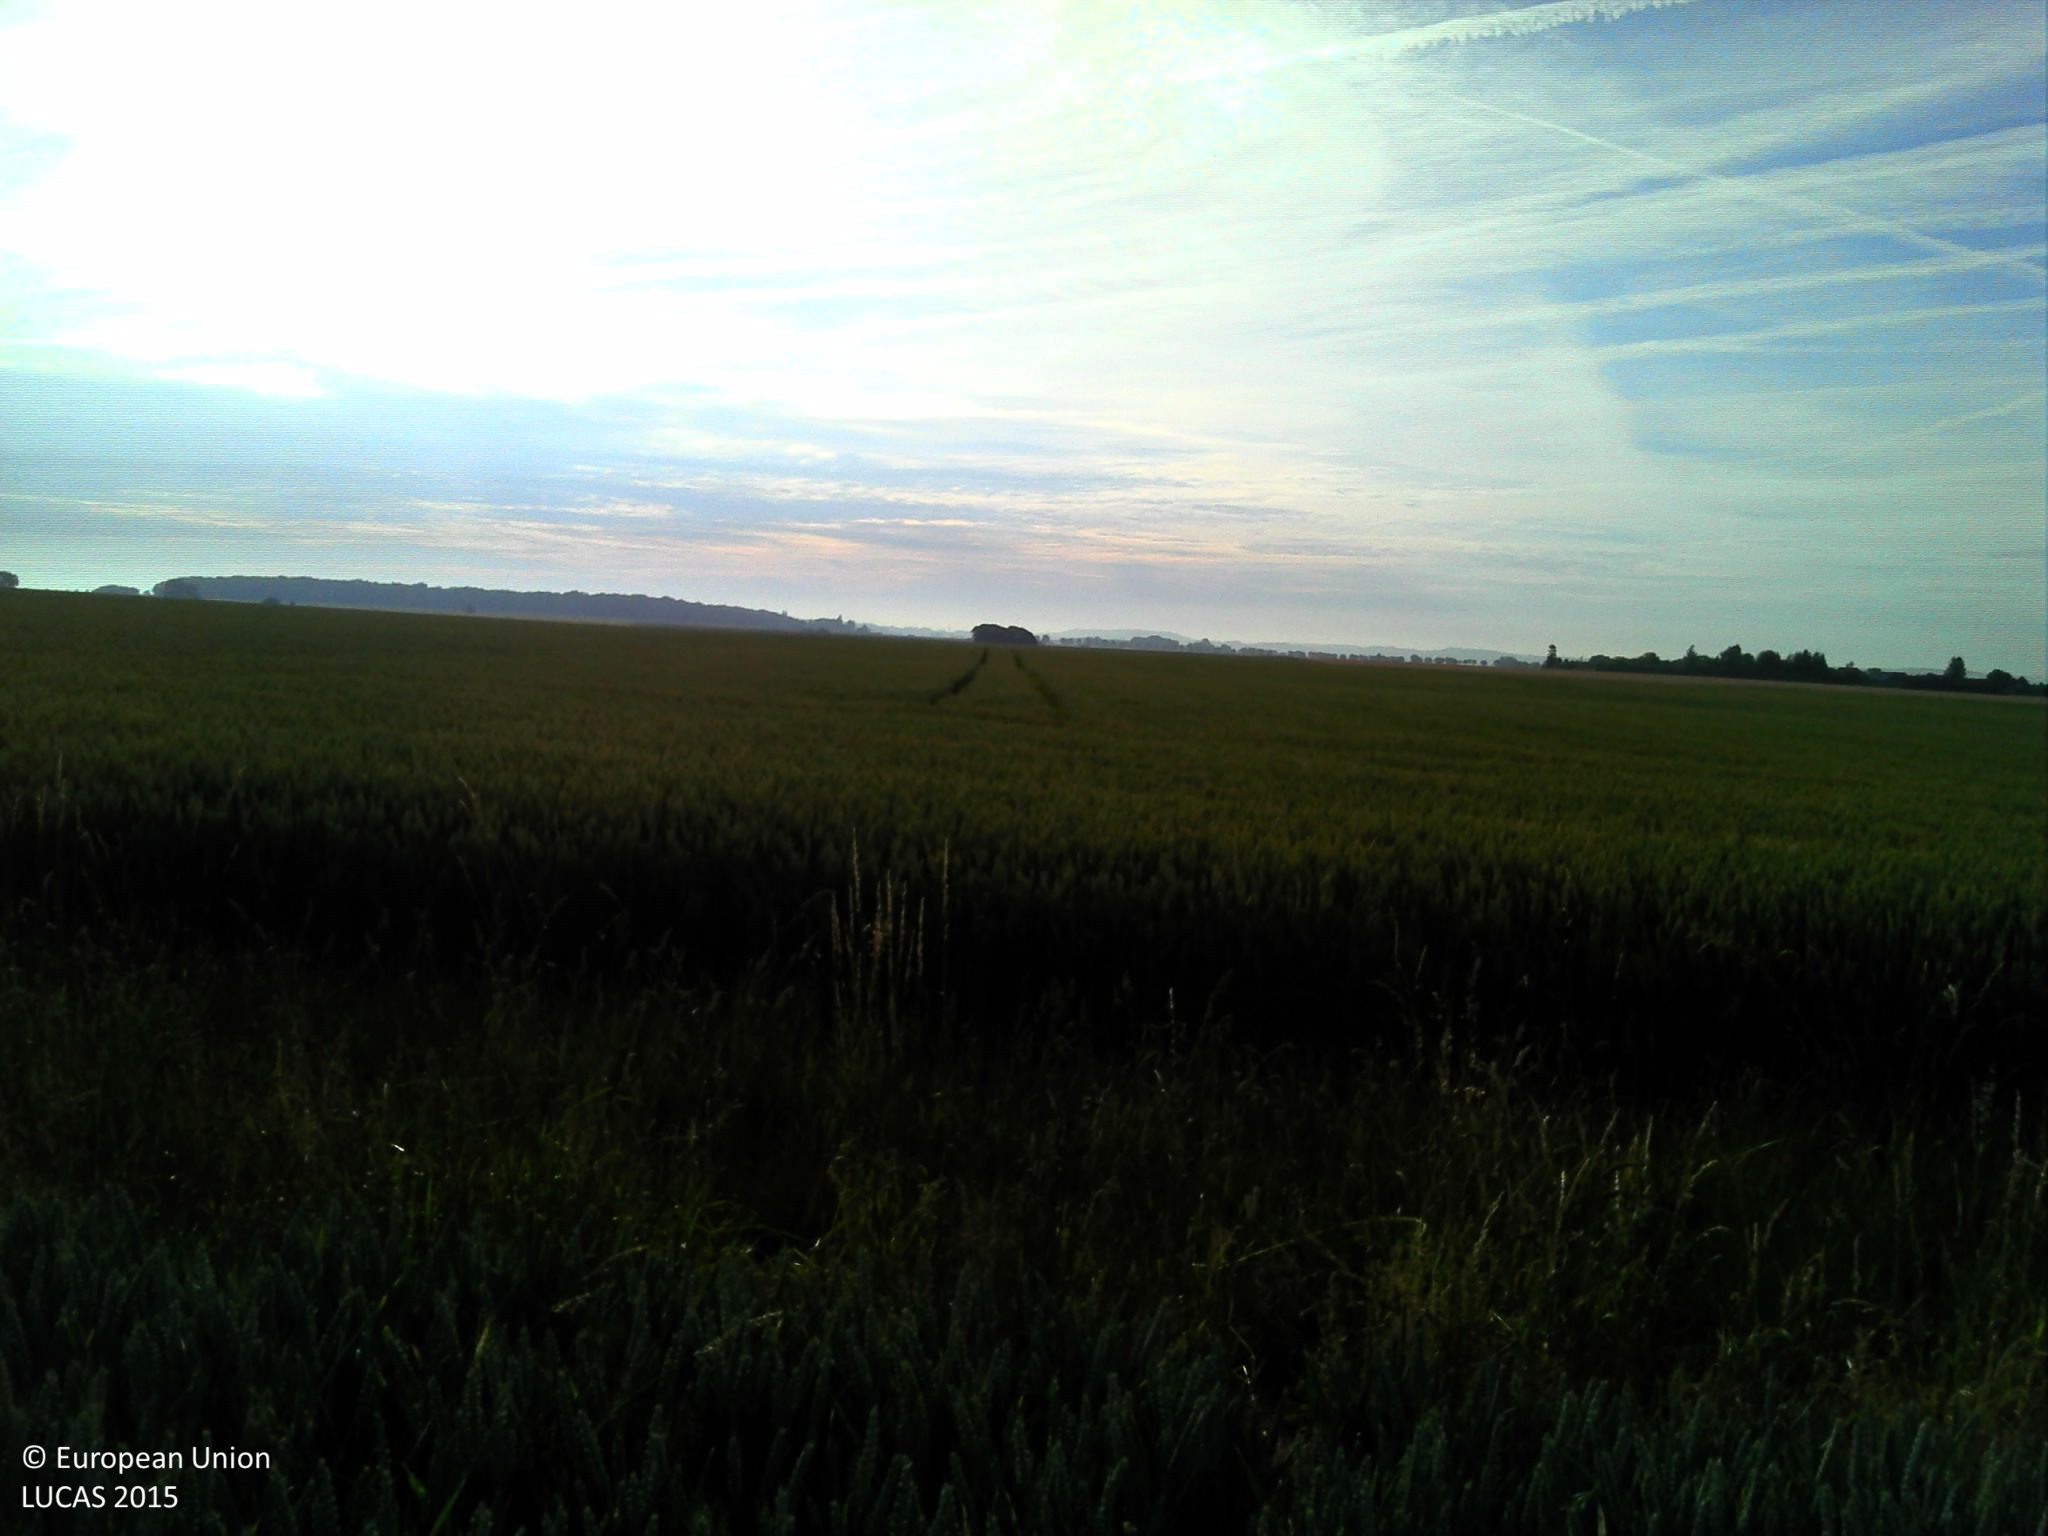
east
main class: Cropland
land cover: Common wheat
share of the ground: > 75 %
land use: Agriculture (excluding fallow land and kitchen gardens)
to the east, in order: Common wheat; Grass margins; Tracks; Grass margins; Common wheat
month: June
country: FR
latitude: 49.4011
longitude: 2.5886
